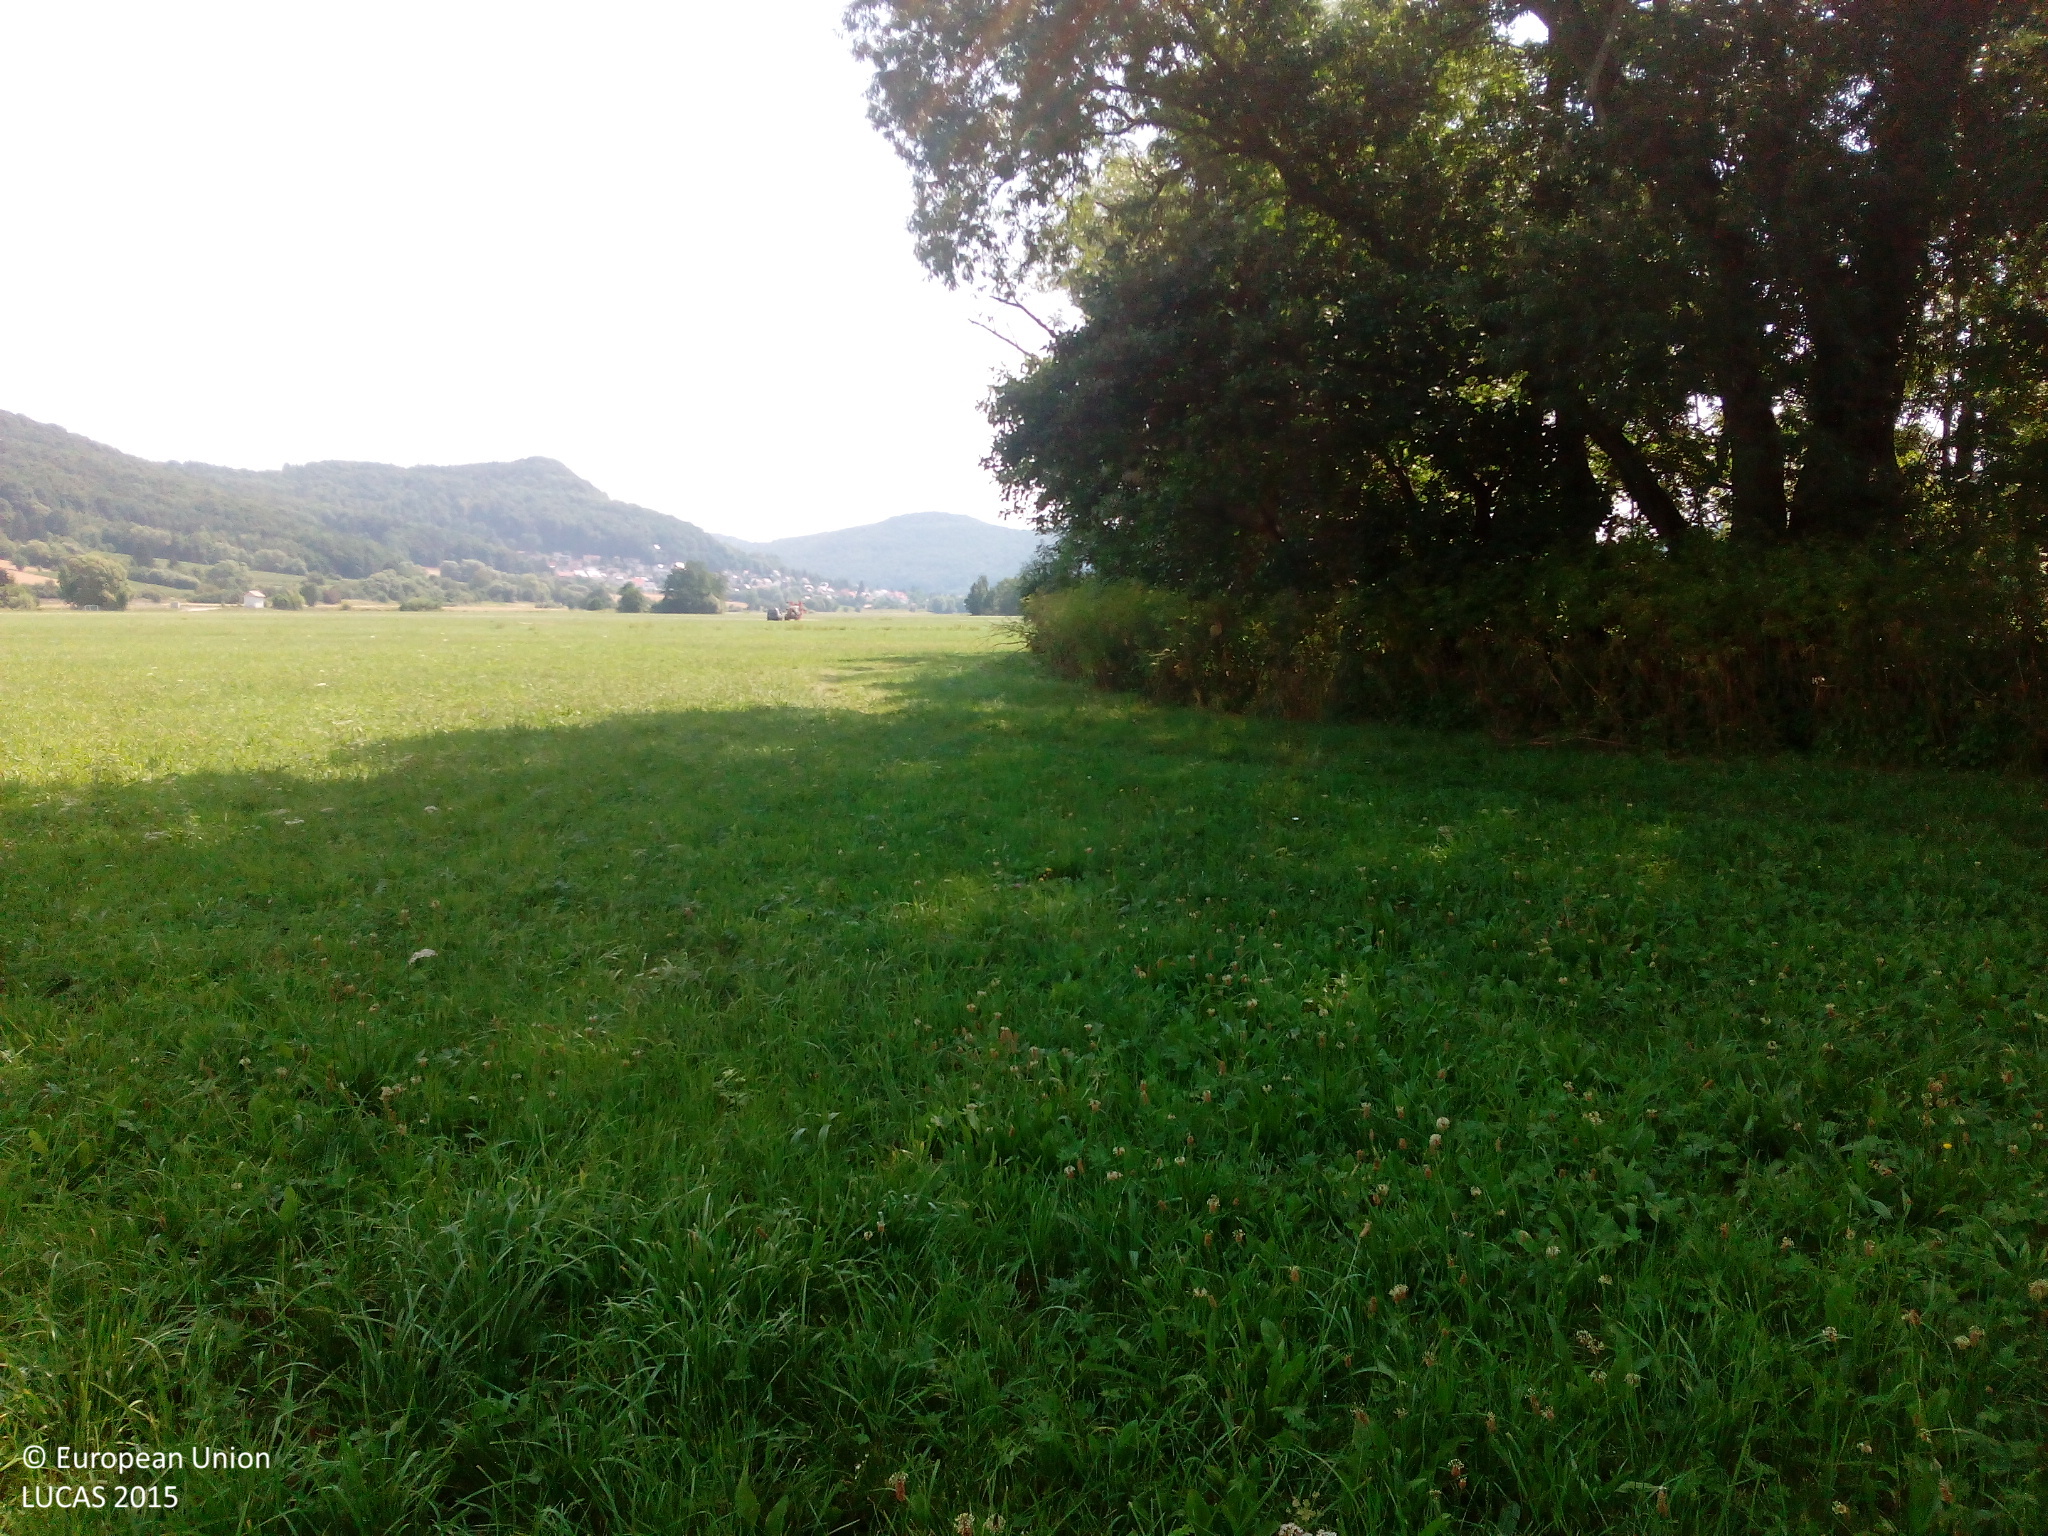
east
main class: Grassland
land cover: Grassland without tree/shrub cover
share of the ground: > 75 %
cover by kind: herbaceous plants 100 %
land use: Agriculture (excluding fallow land and kitchen gardens)
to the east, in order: Grassland without tree/shrub cover
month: July
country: DE
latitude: 49.5095
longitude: 11.4497
